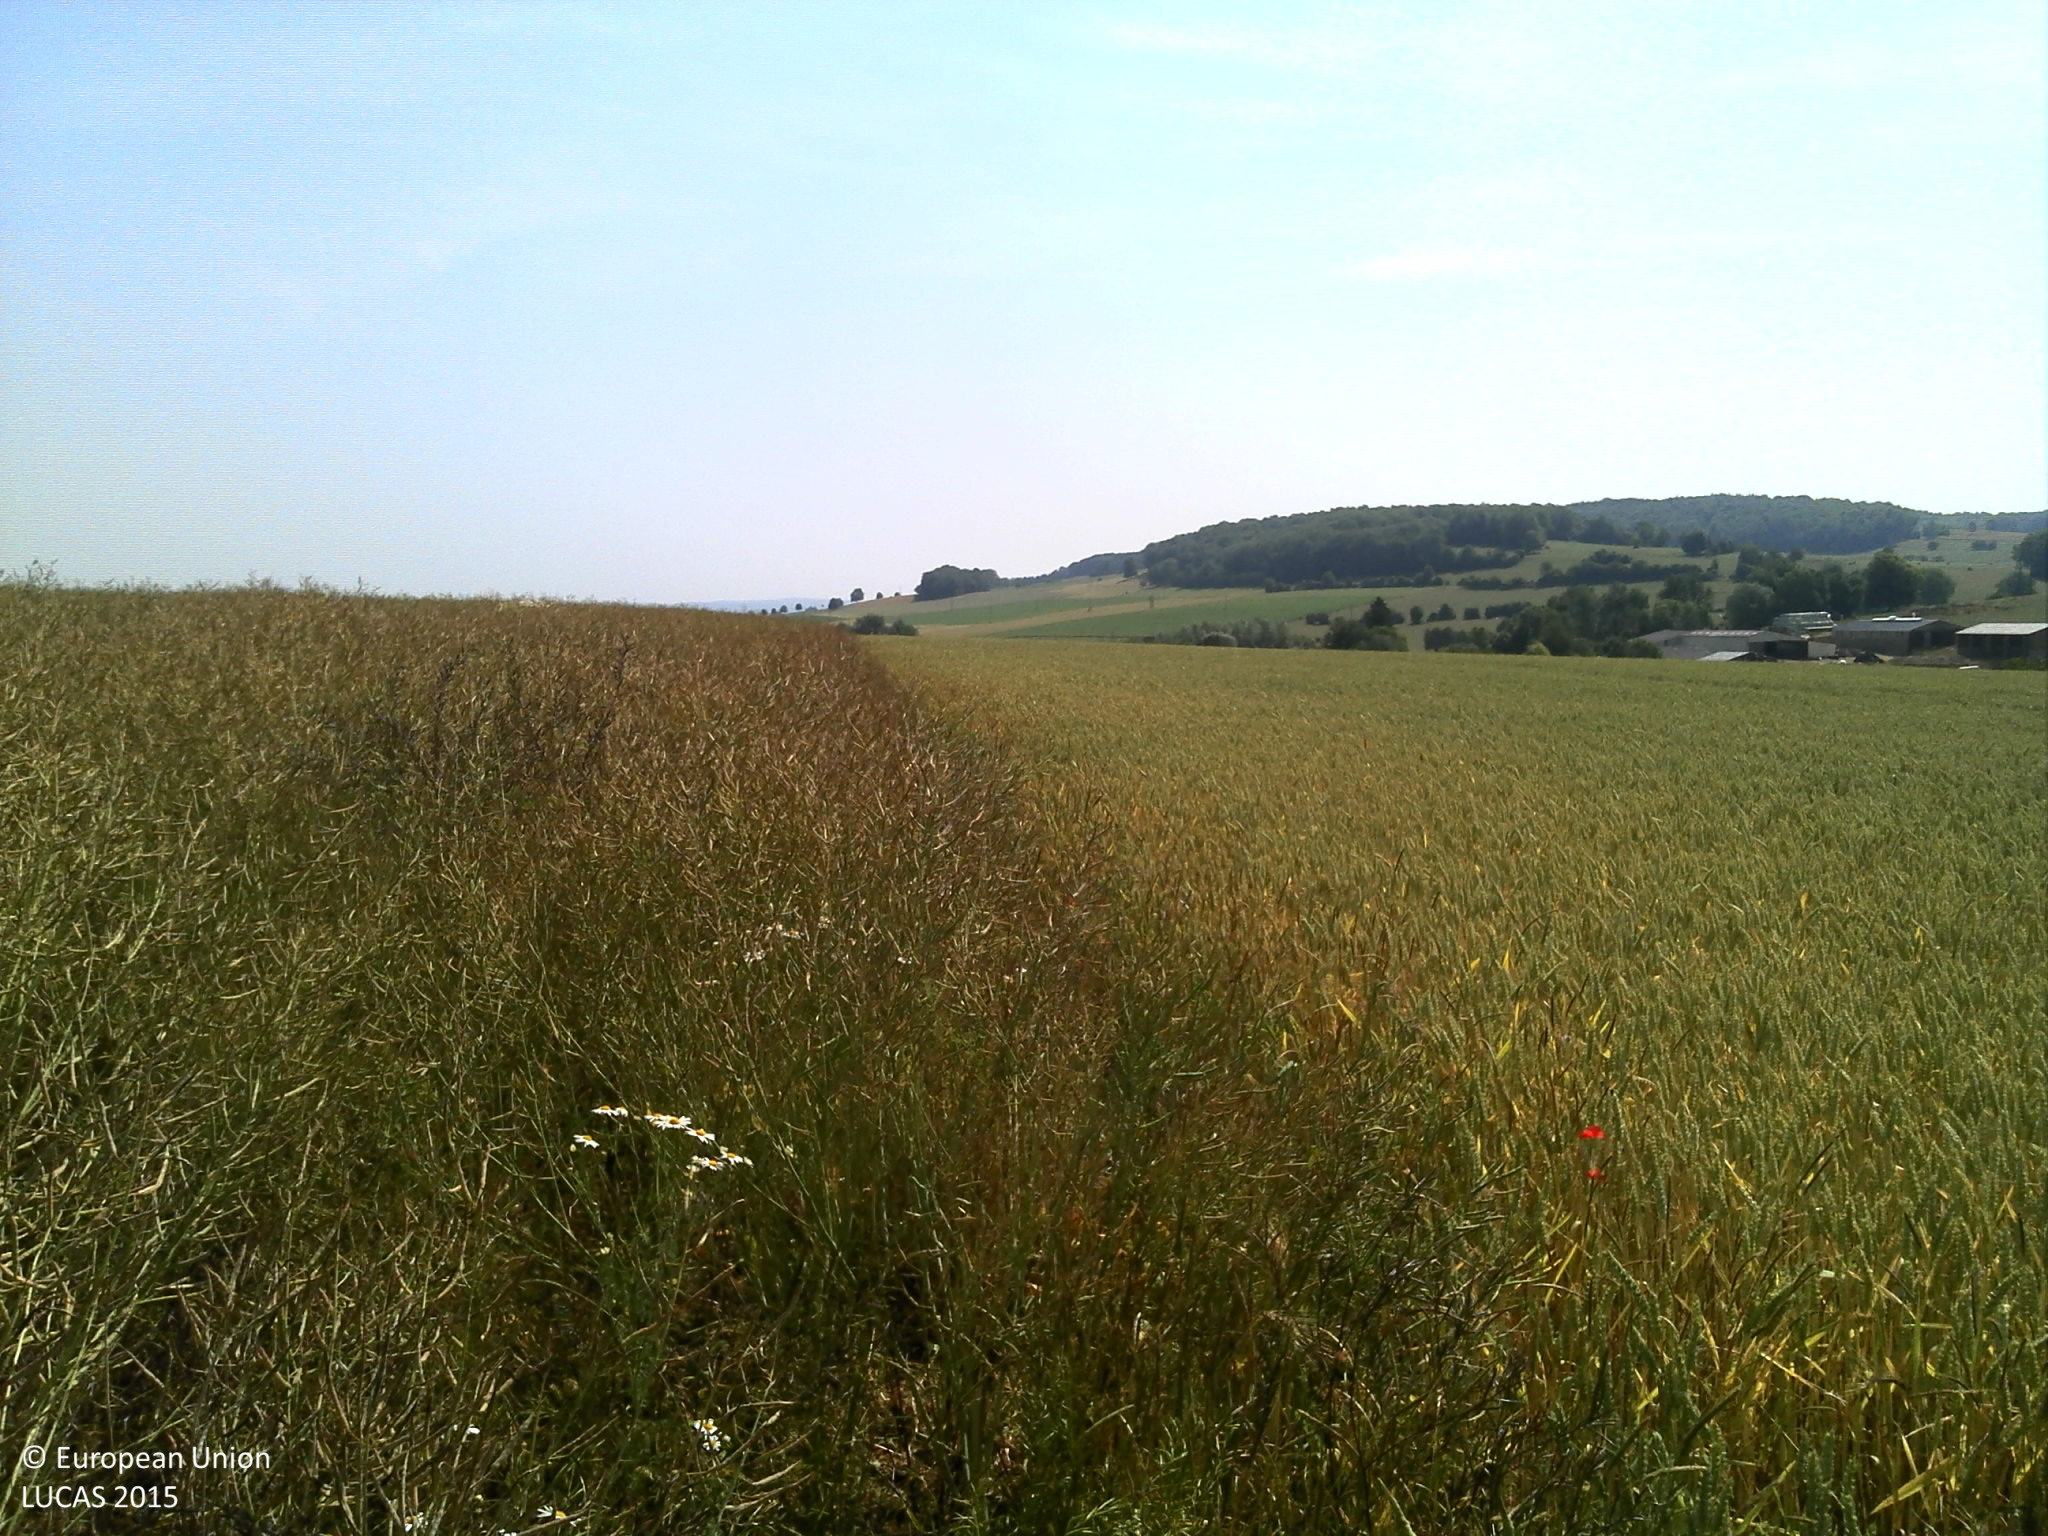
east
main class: Cropland
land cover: Rape and turnip rape
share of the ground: > 75 %
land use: Agriculture (excluding fallow land and kitchen gardens)
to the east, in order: Rape and turnip rape; Common wheat; Fences; Grassland without tree/shrub cover
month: July
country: FR
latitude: 49.7790
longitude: 4.4549
